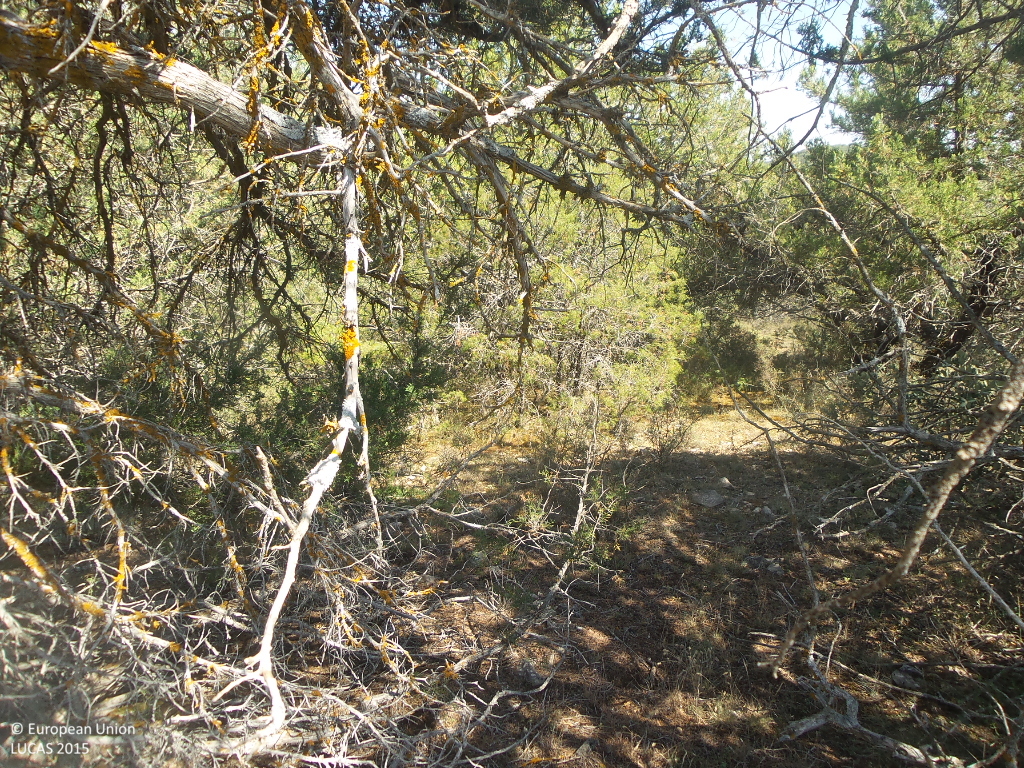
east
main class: Woodland
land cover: Other coniferous woodland
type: coniferous forest of the mediterranean region
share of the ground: 50 - 75 %
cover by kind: coniferous forest trees 50 %, shrubs 35 %, herbaceous plants 10 %, lichens and mosses 5 %
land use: Semi-natural and natural areas not in use
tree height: > 5 m
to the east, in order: Other coniferous woodland
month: July
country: ES
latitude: 41.0909
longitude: -2.0623
